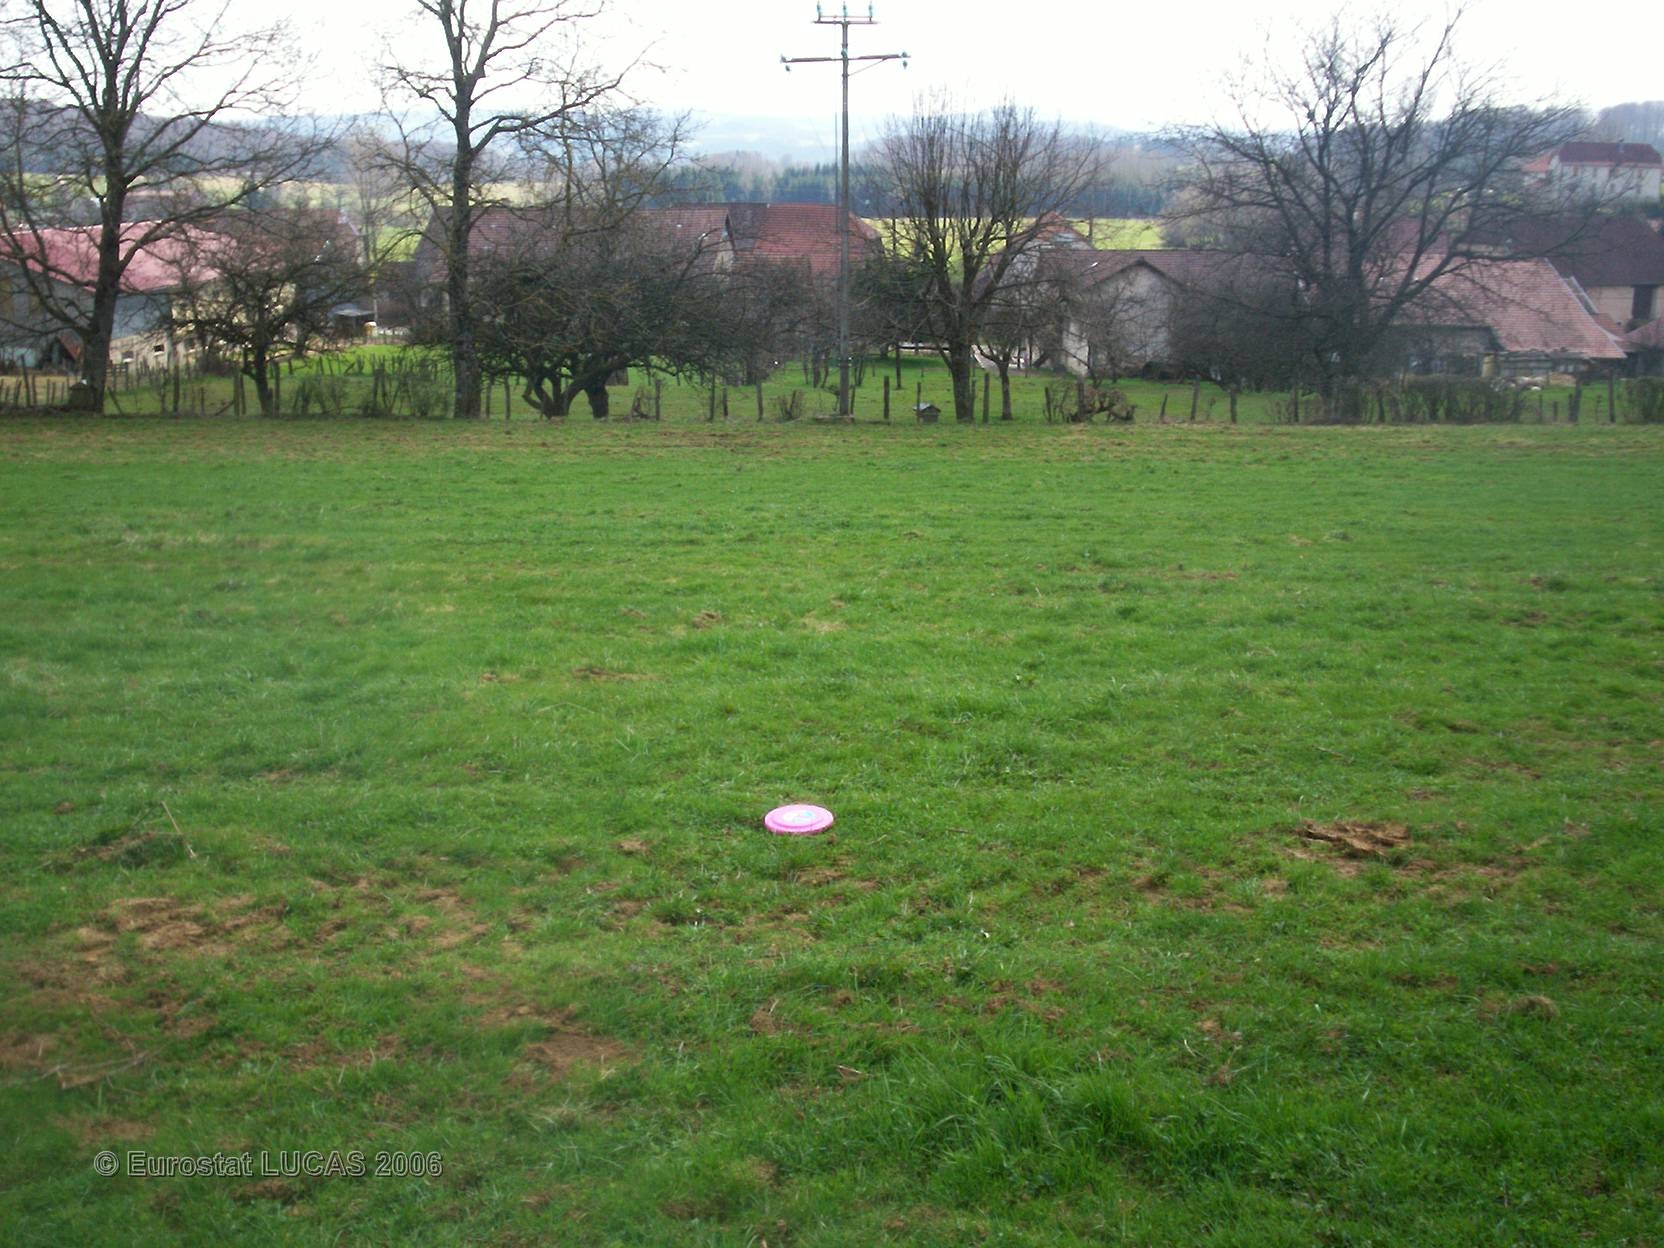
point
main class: Grassland
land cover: Grassland without tree/shrub cover
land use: Agriculture (excluding fallow land and kitchen gardens)
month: April
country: FR
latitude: 47.3497
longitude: 6.8381
